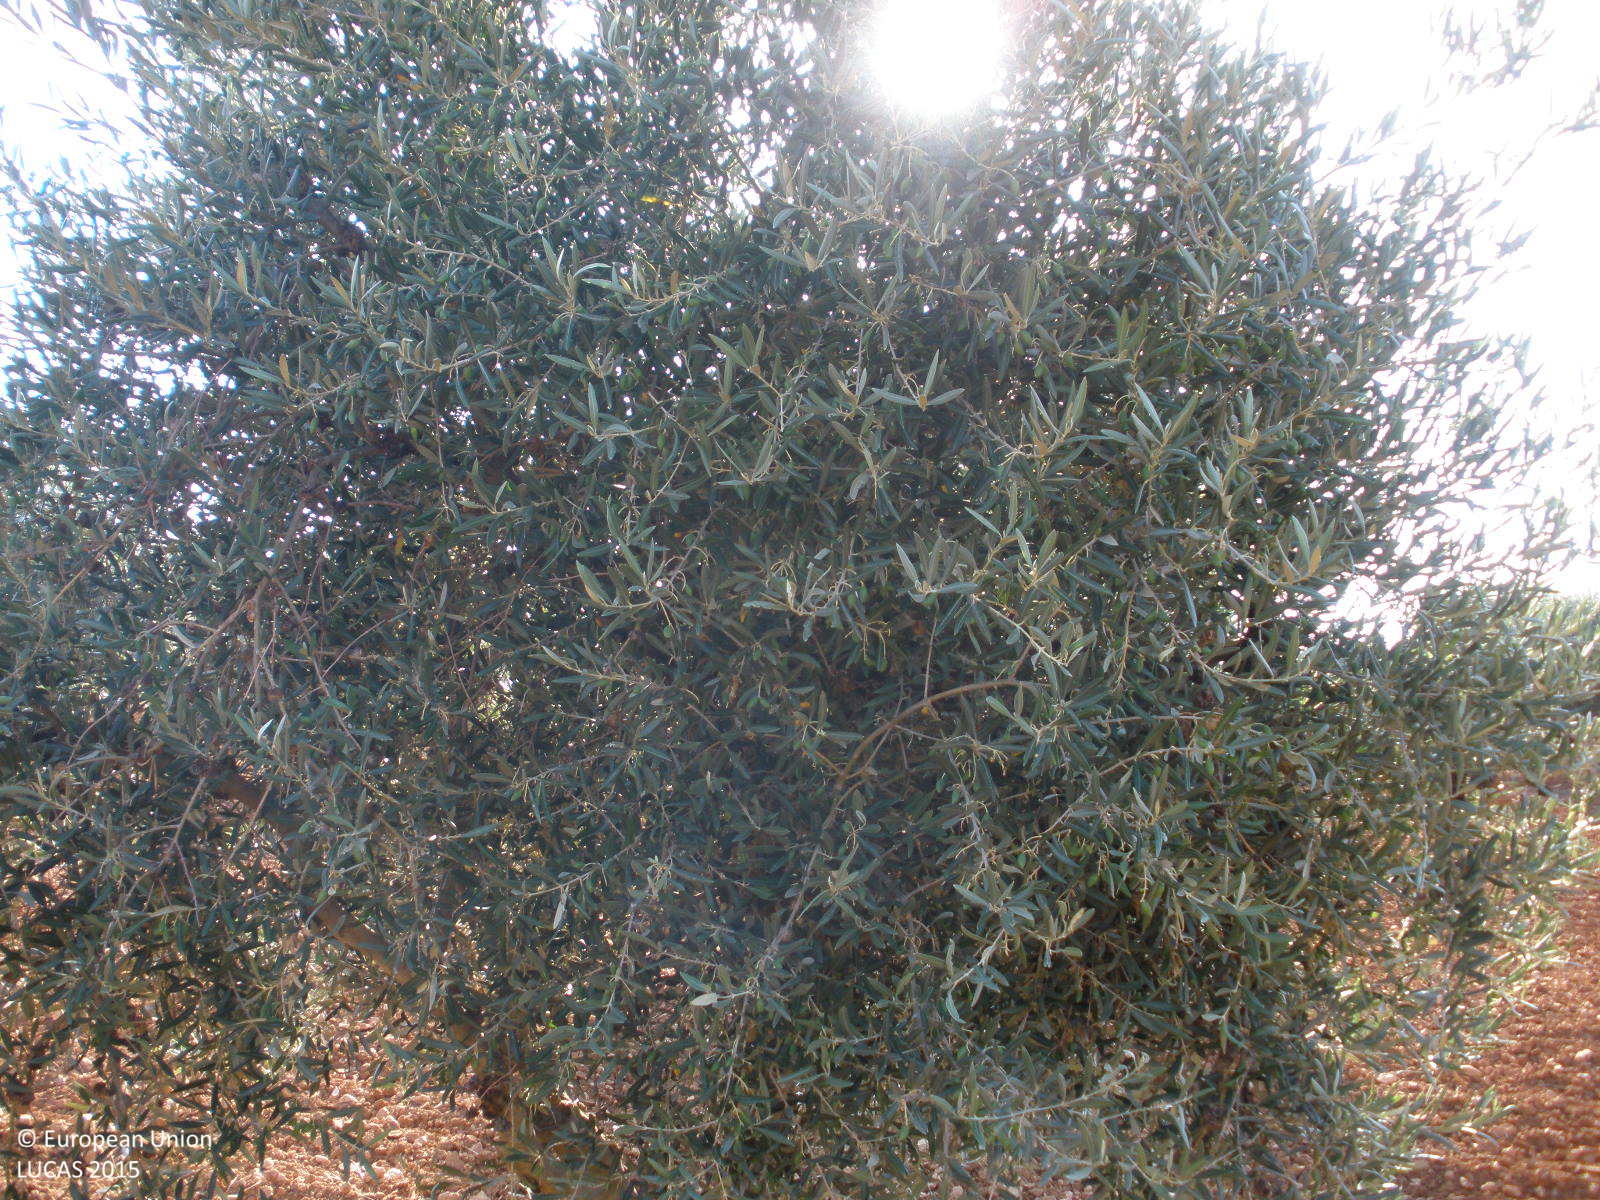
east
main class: Cropland
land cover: Olive groves
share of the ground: 50 - 75 %
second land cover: Other bare soil
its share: > 75 %
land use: Agriculture (excluding fallow land and kitchen gardens)
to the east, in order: Olive groves; Other bare soil; Electric lines; Vineyards; Tracks; Vineyards; Electric lines; Vineyards; Olive groves; Electric lines; Olive groves; Shruby margins; Paved roads, cycling and walking lanes; Shruby margins; Olive groves; Electric lines; Olive groves
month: June
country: ES
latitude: 40.1199
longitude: -3.3470
